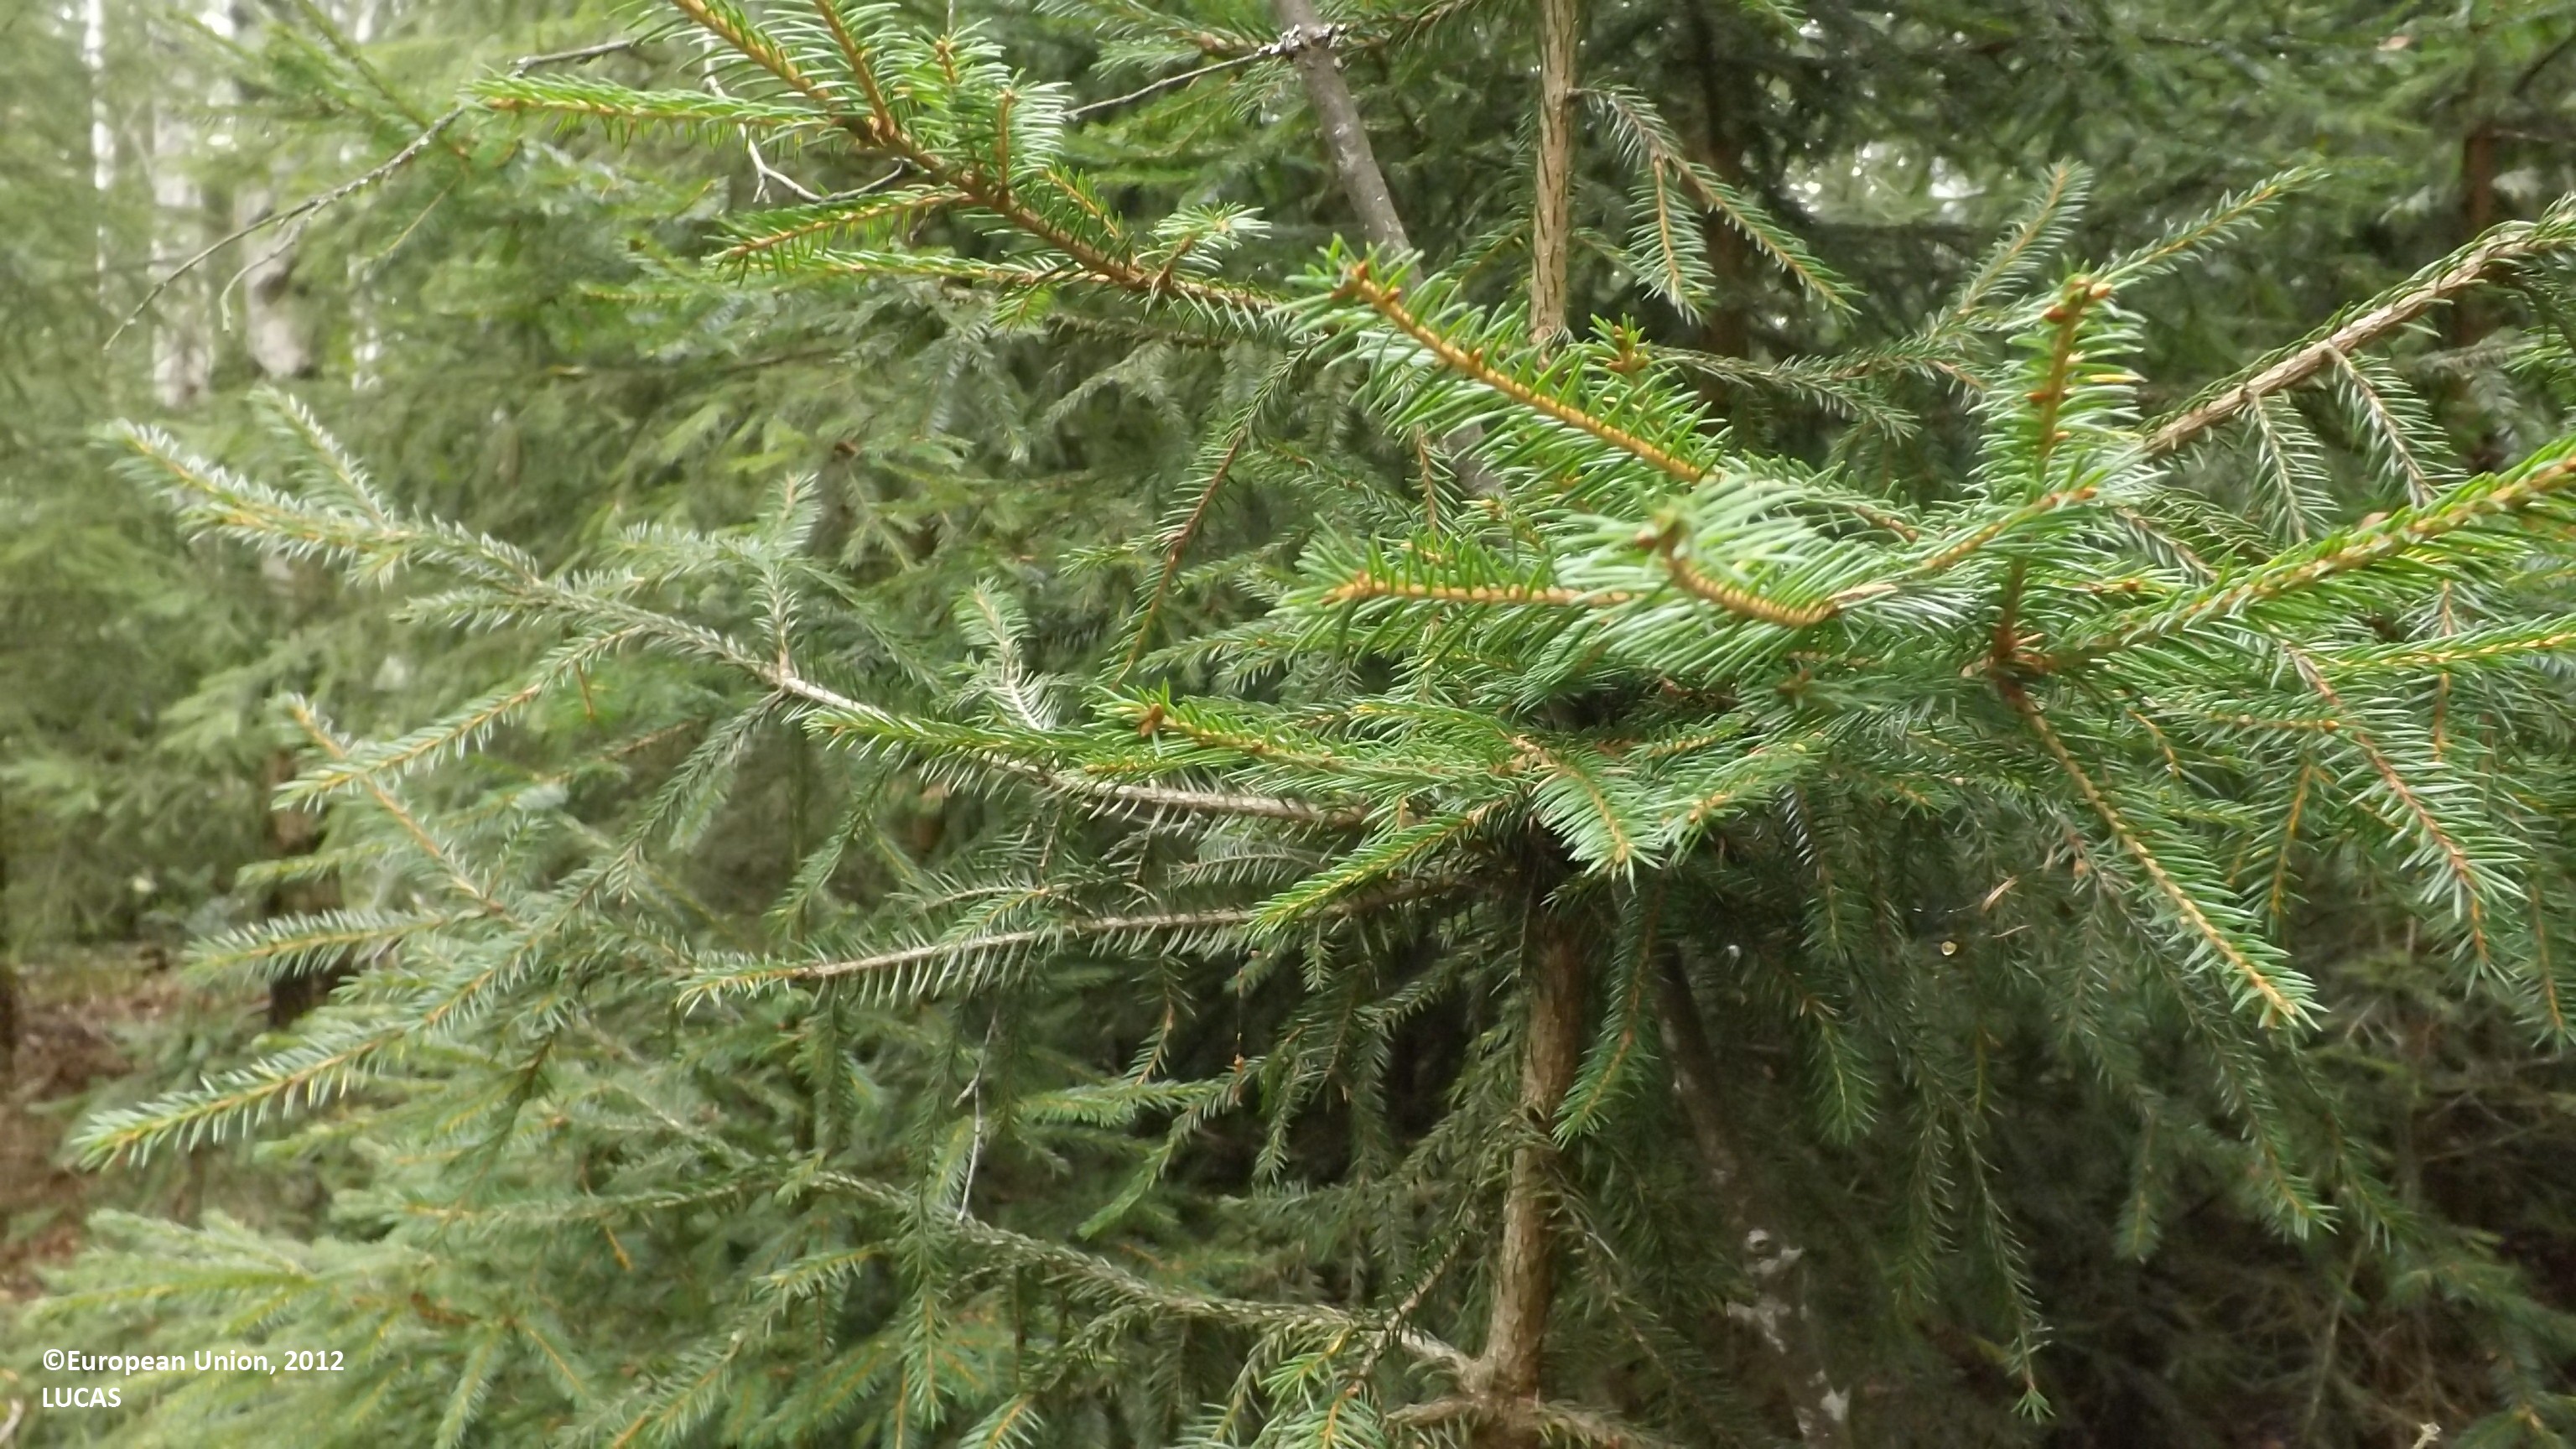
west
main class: Woodland
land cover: Other mixed woodland
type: boreal forest
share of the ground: 50 - 75 %
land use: Forestry
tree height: > 5 m
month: August
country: FI
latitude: 63.7731
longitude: 23.3824
